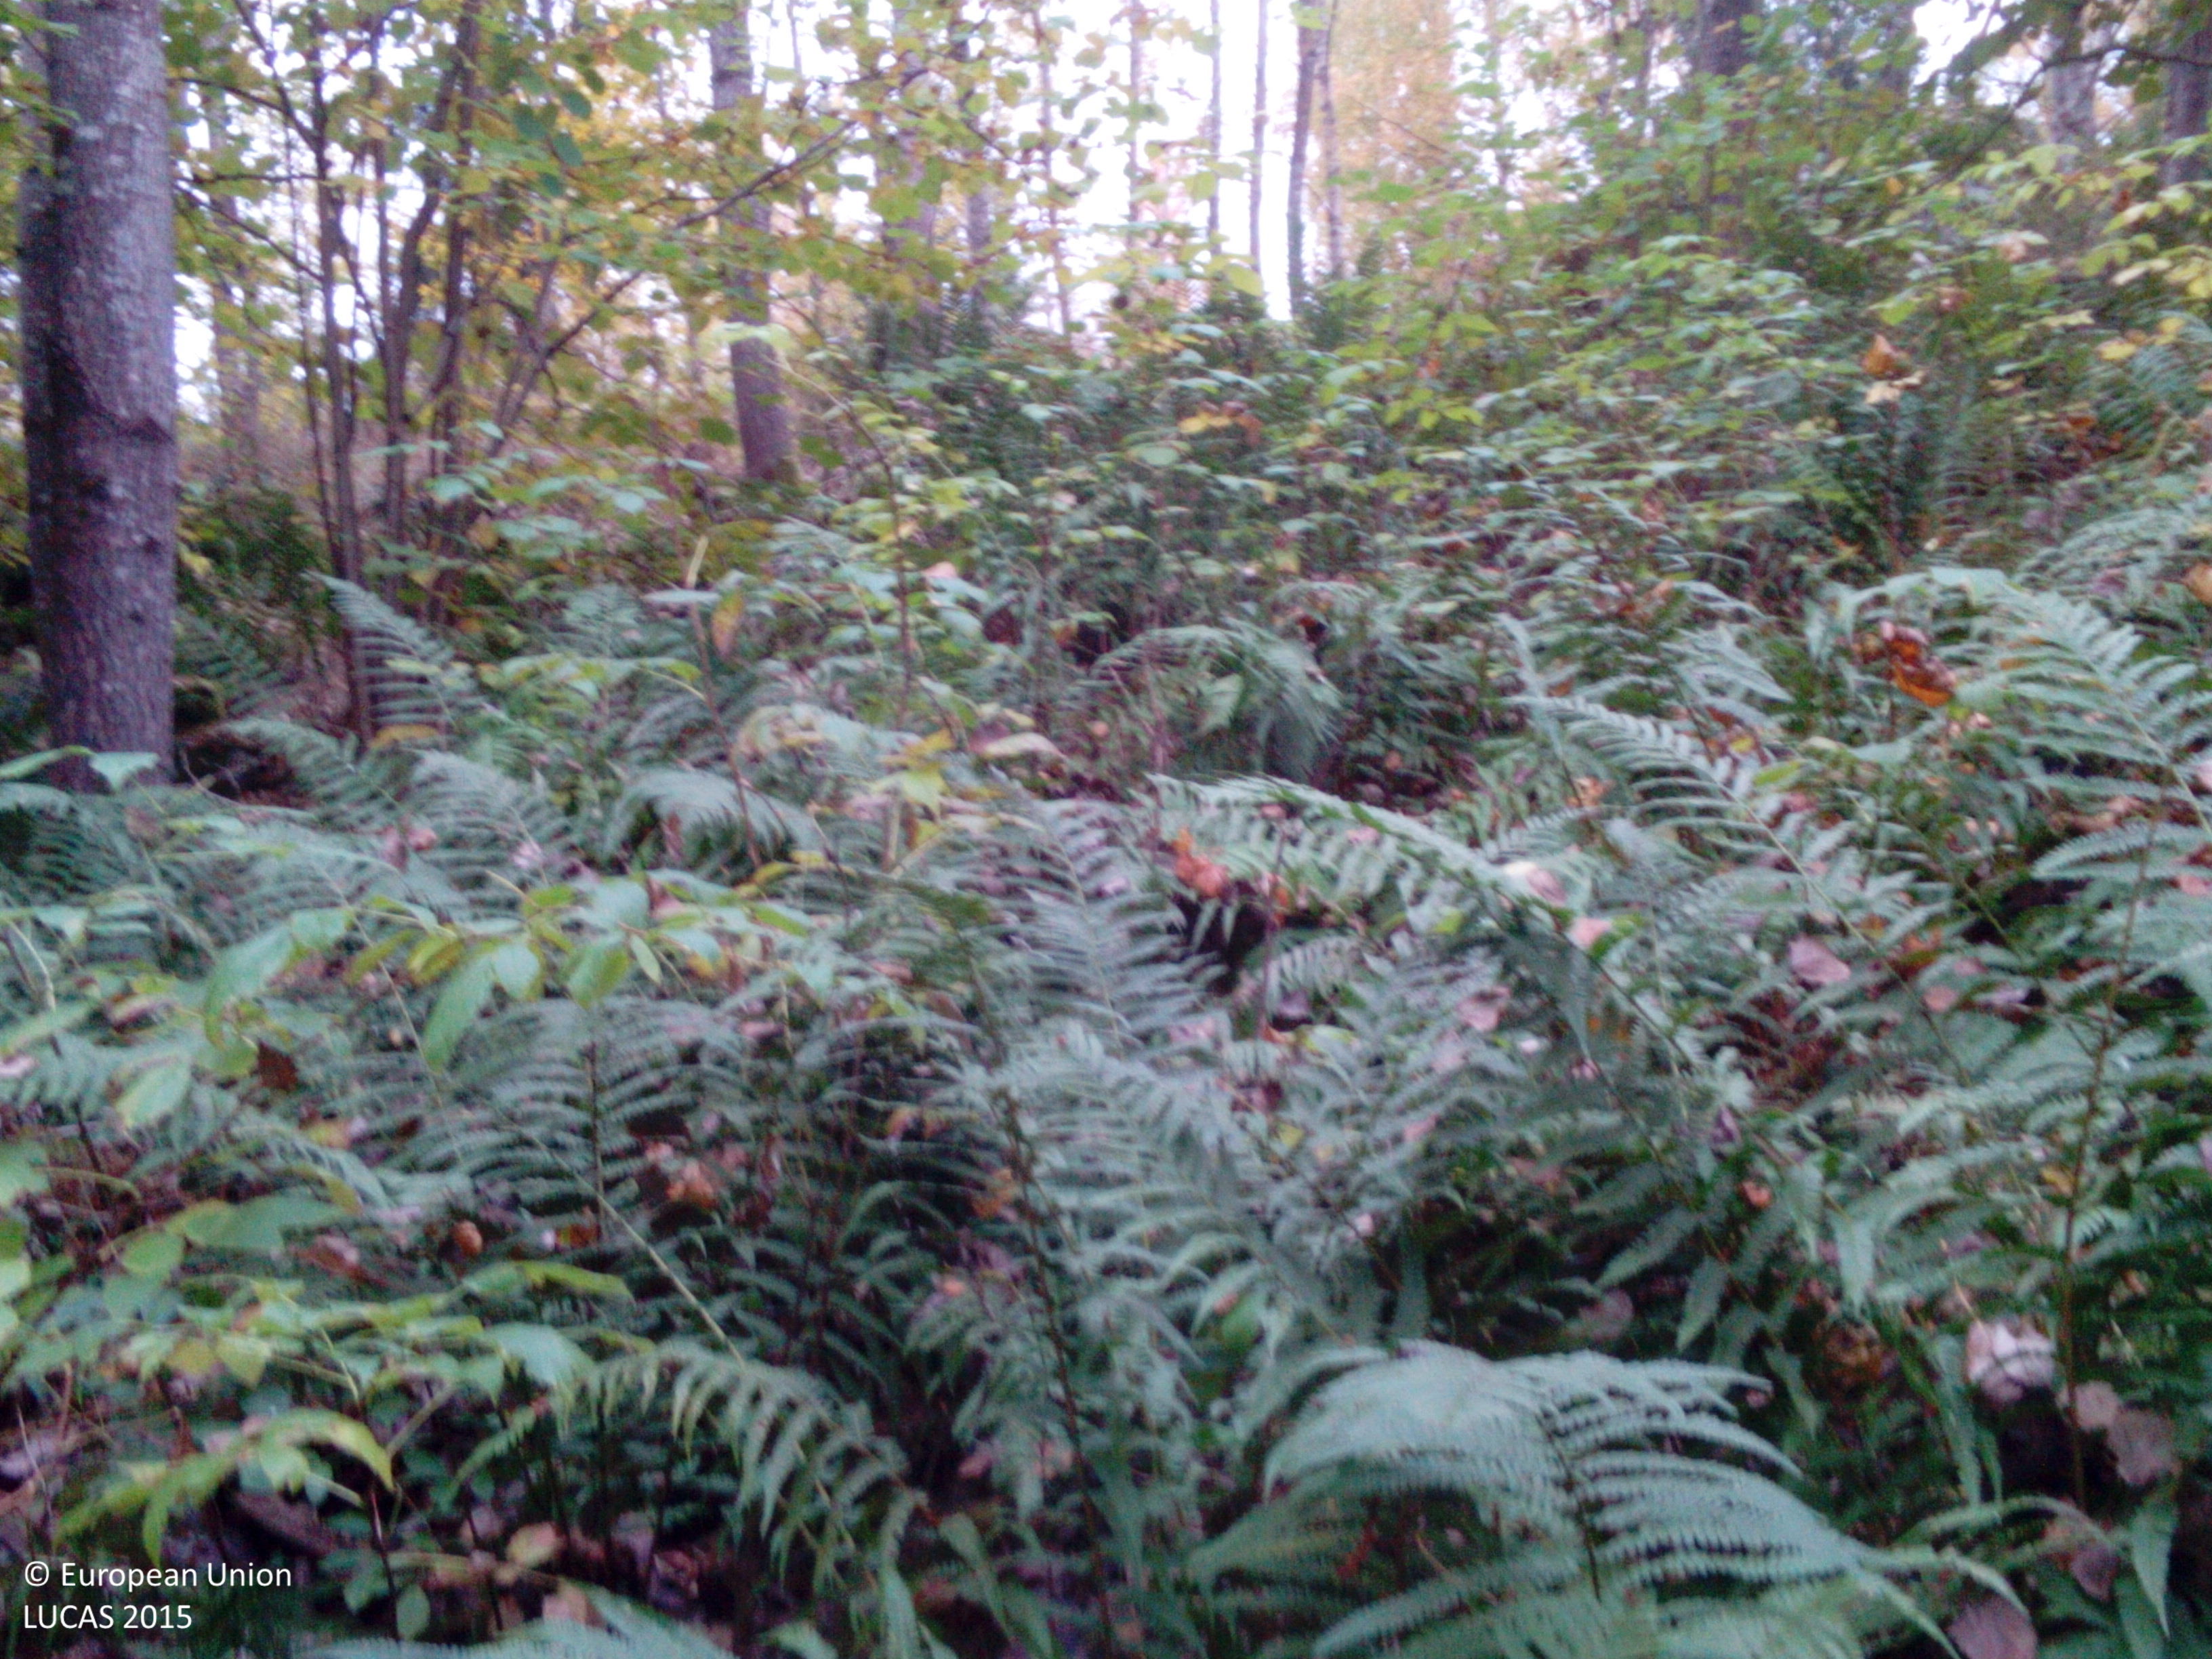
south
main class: Woodland
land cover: Broadleaved woodland
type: hemiboreal forest and nemoral coniferous forest and mixed broadleaved-coniferous forest
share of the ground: > 75 %
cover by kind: broadleaved forest trees 80 %, shrubs 10 %, herbaceous plants 10 %
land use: Forestry
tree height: > 5 m
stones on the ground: 25 - 50 %
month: October
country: SE
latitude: 58.8211
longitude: 16.4891
